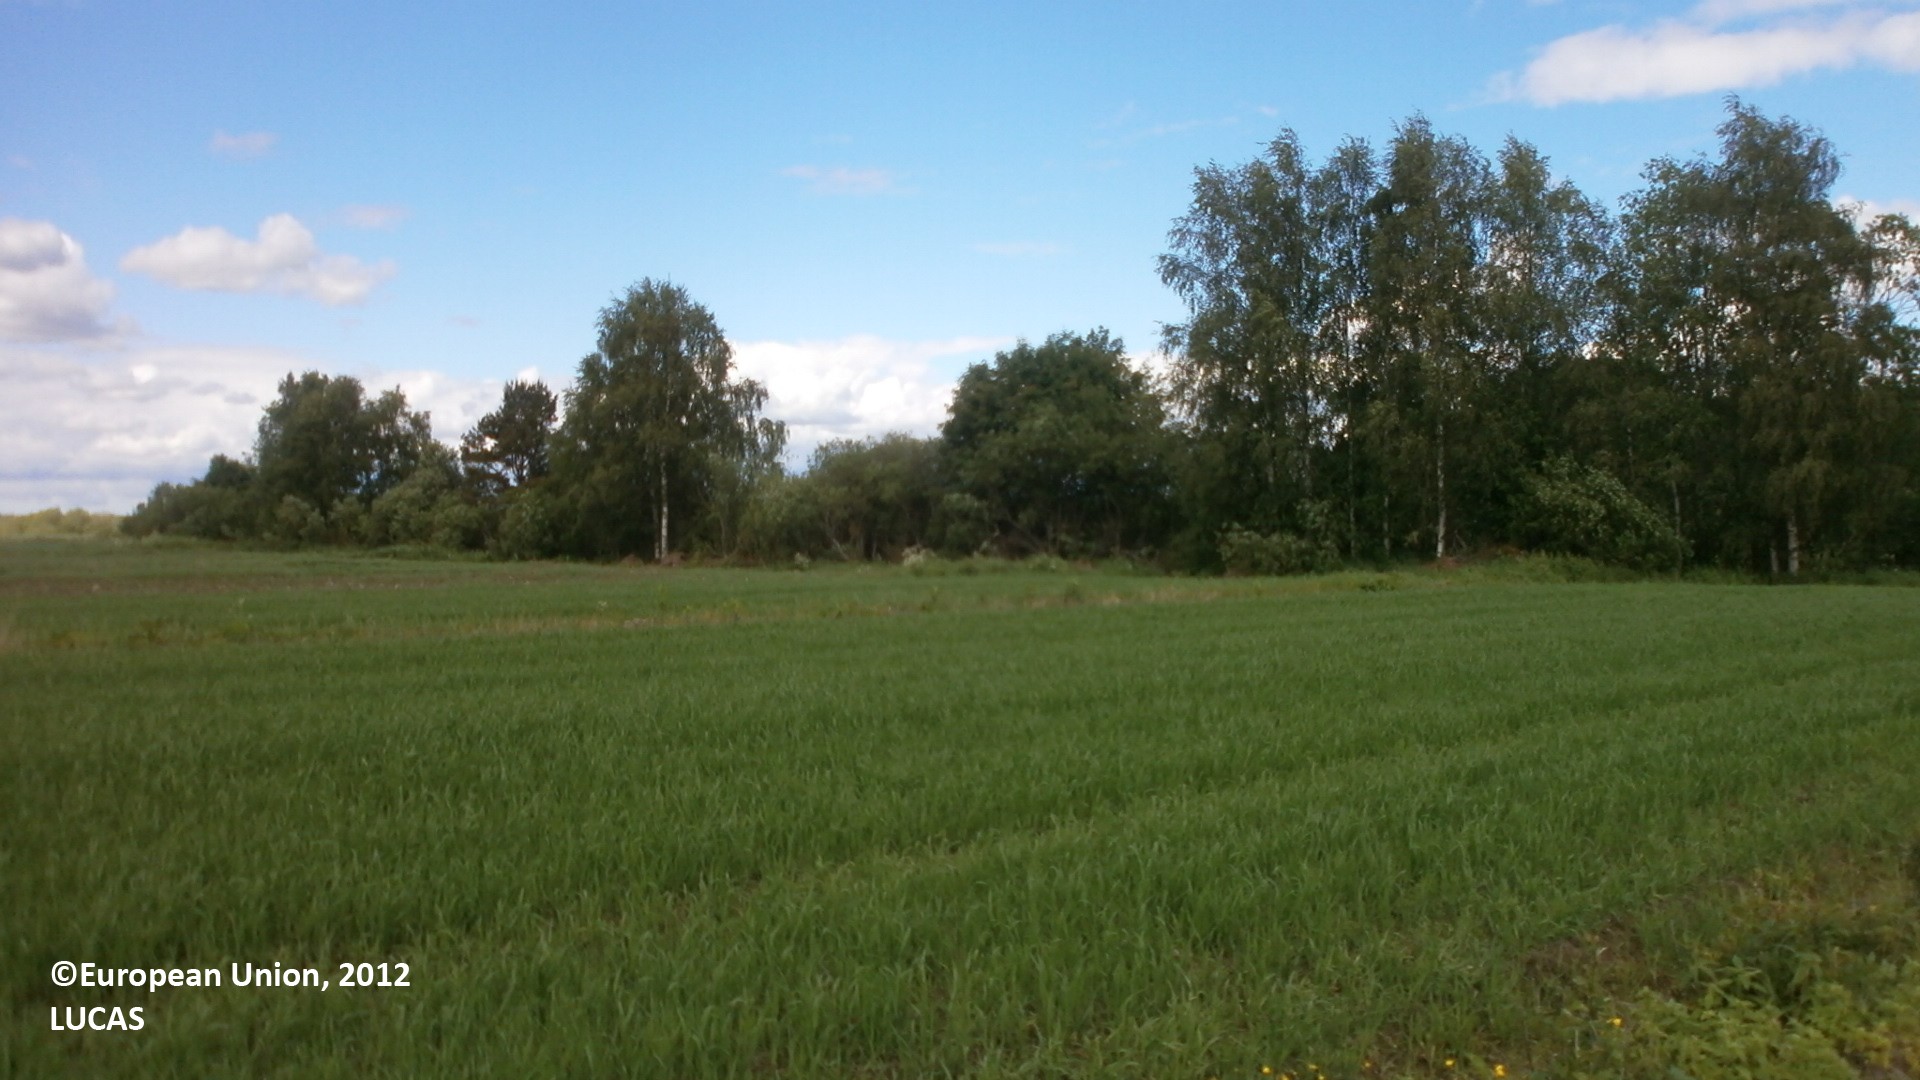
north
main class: Cropland
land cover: Oats
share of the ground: > 75 %
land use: Agriculture (excluding fallow land and kitchen gardens)
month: June
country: FI
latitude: 64.2770
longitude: 24.9278
